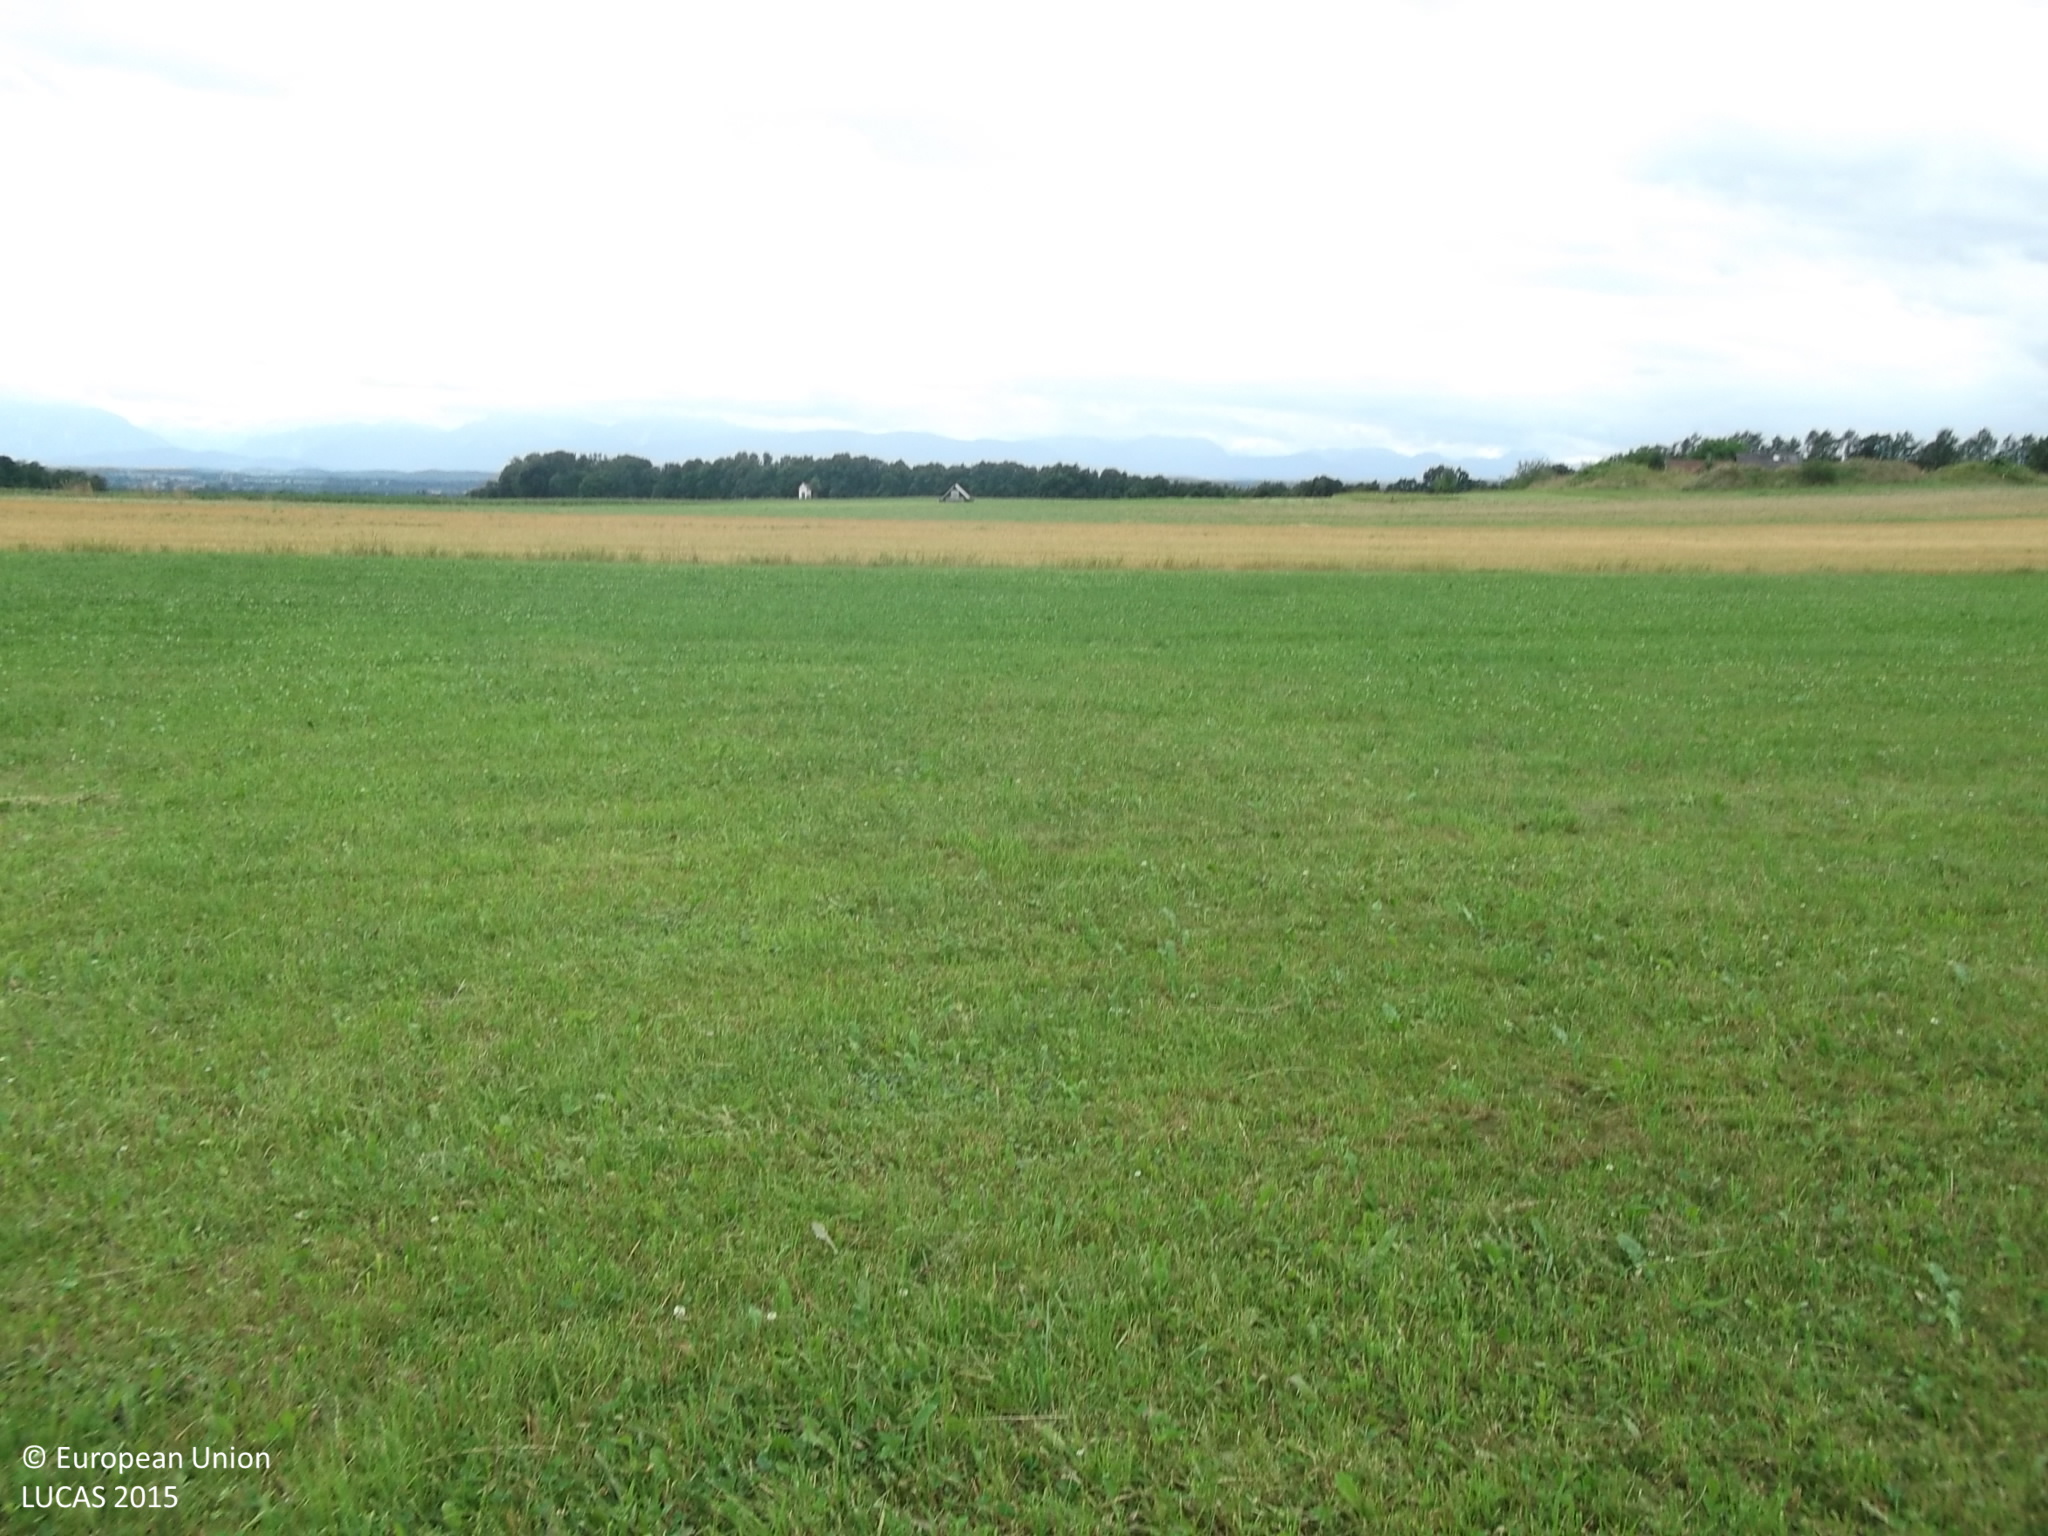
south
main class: Grassland
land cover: Grassland without tree/shrub cover
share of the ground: > 75 %
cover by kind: herbaceous plants 100 %
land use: Agriculture (excluding fallow land and kitchen gardens)
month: July
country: AT
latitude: 48.0619
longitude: 12.8033
